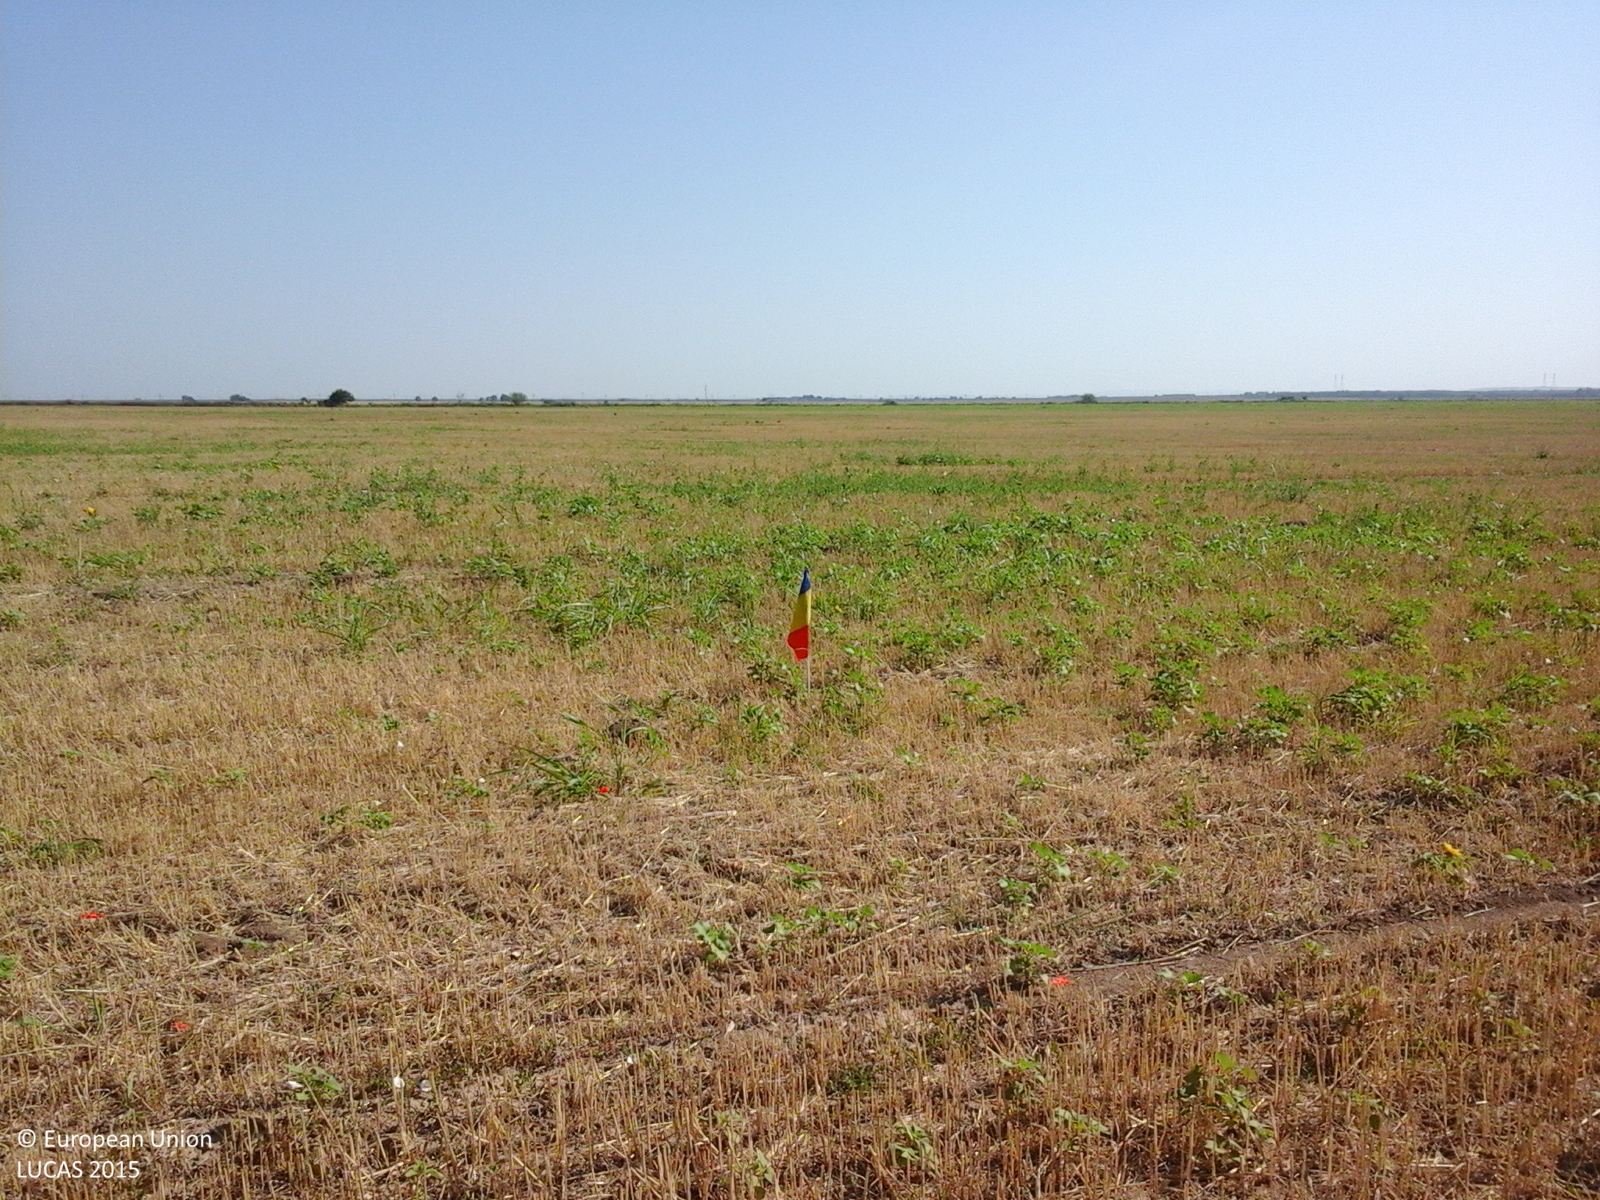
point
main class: Cropland
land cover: Durum wheat
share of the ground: 25 - 50 %
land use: Agriculture (excluding fallow land and kitchen gardens)
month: July
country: RO
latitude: 44.3194
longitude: 27.9460
